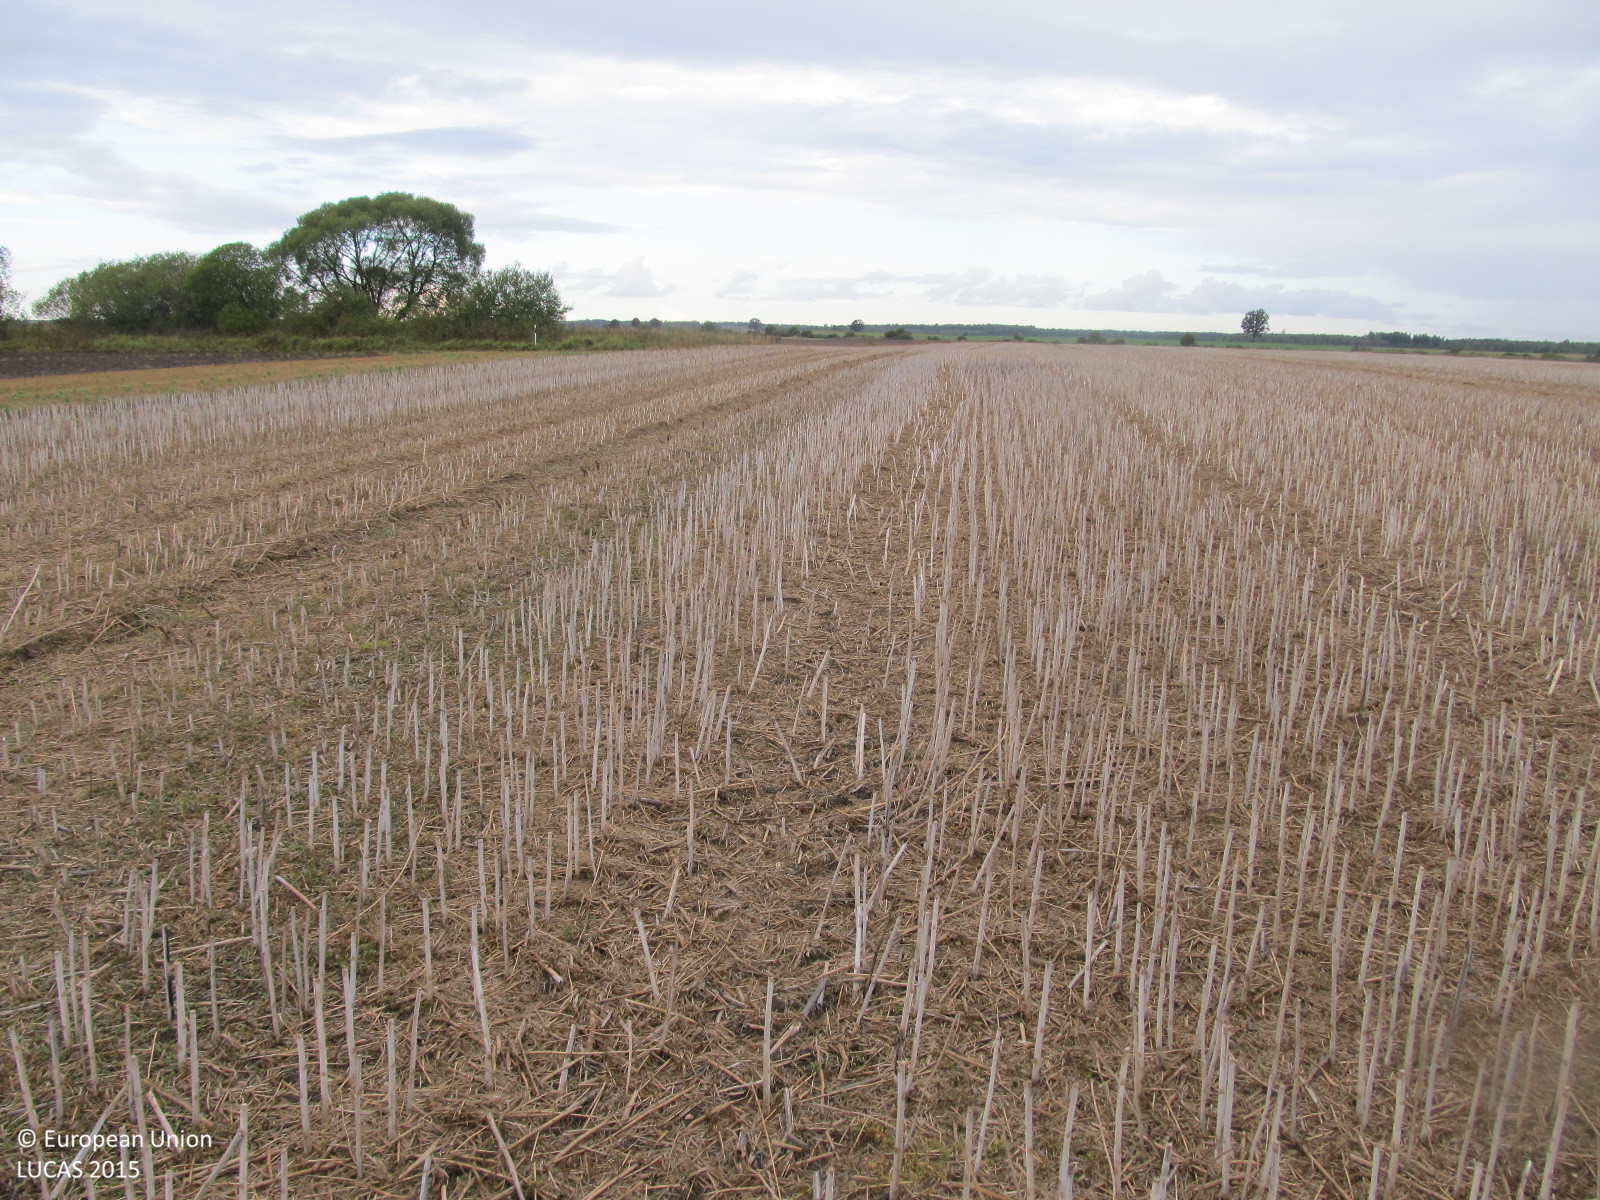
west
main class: Cropland
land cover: Rape and turnip rape
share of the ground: > 75 %
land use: Agriculture (excluding fallow land and kitchen gardens)
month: September
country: LT
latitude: 56.1034
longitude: 23.2067
